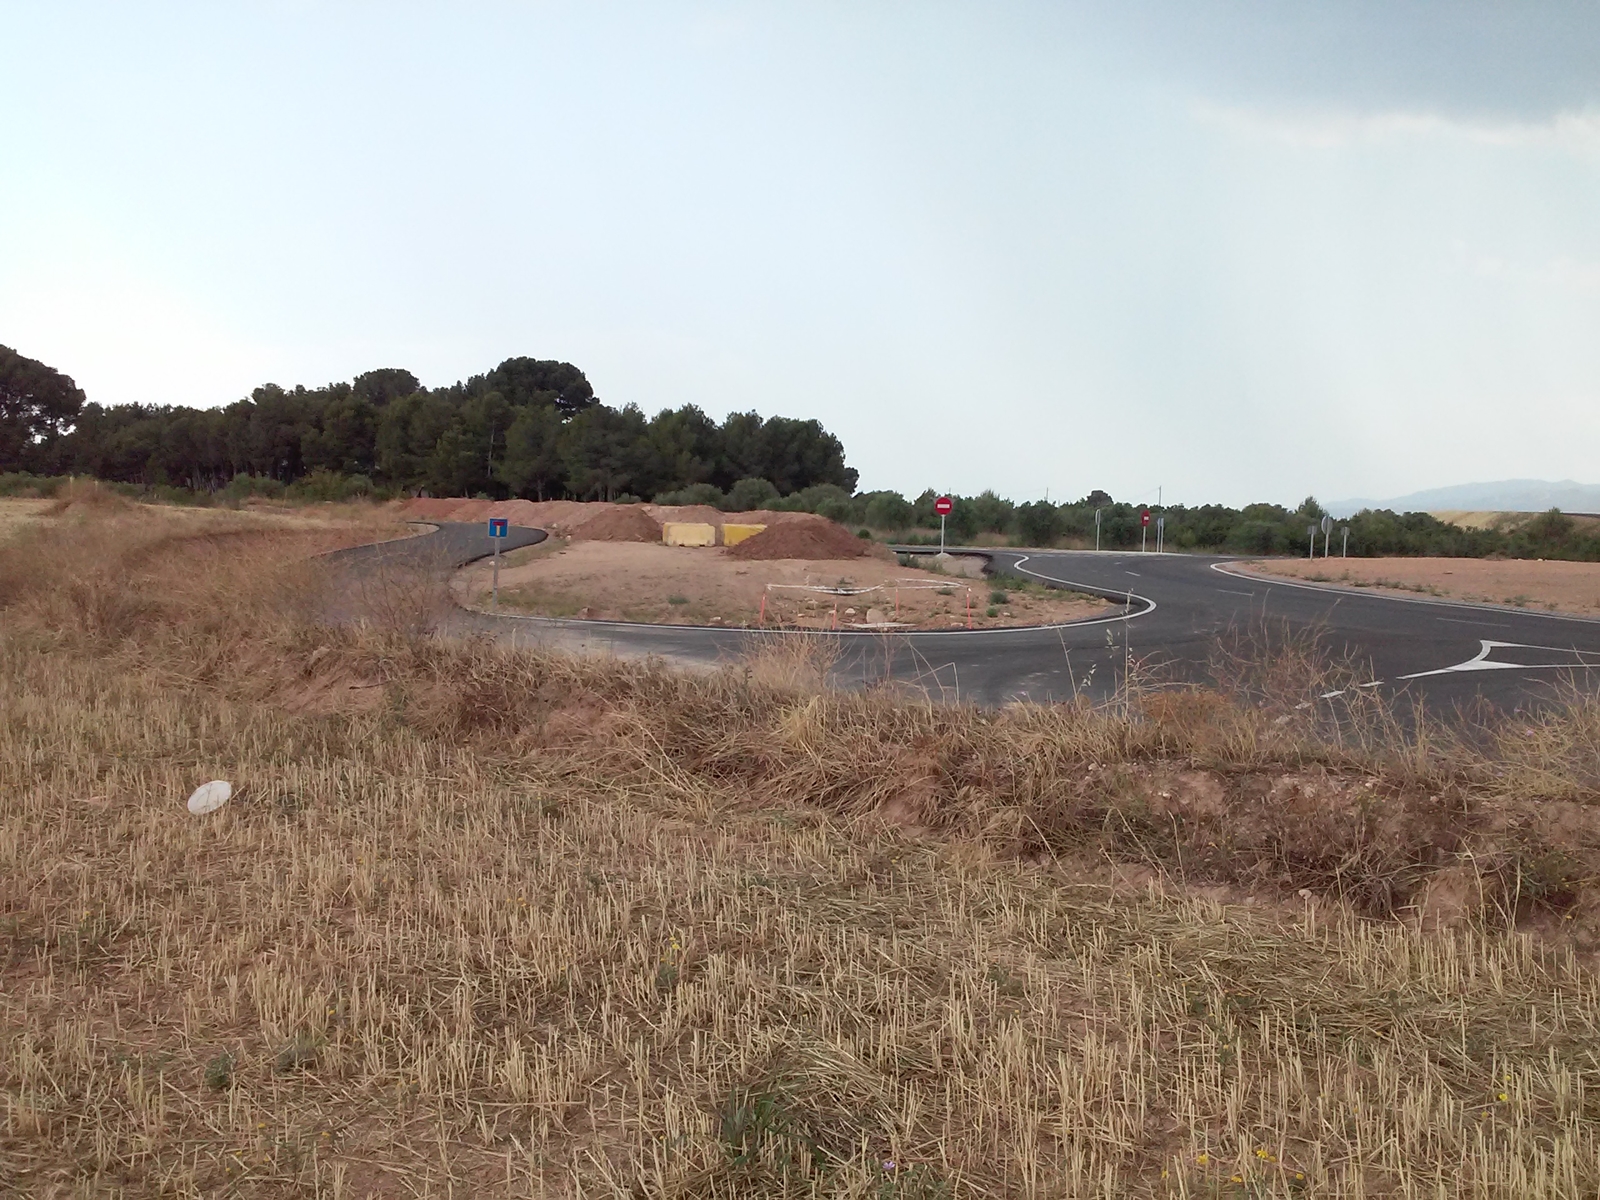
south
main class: Cropland
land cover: Barley
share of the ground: < 10 %
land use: Agriculture (excluding fallow land and kitchen gardens)
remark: Harvested field
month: June
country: ES
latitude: 41.3109
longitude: 1.2369
